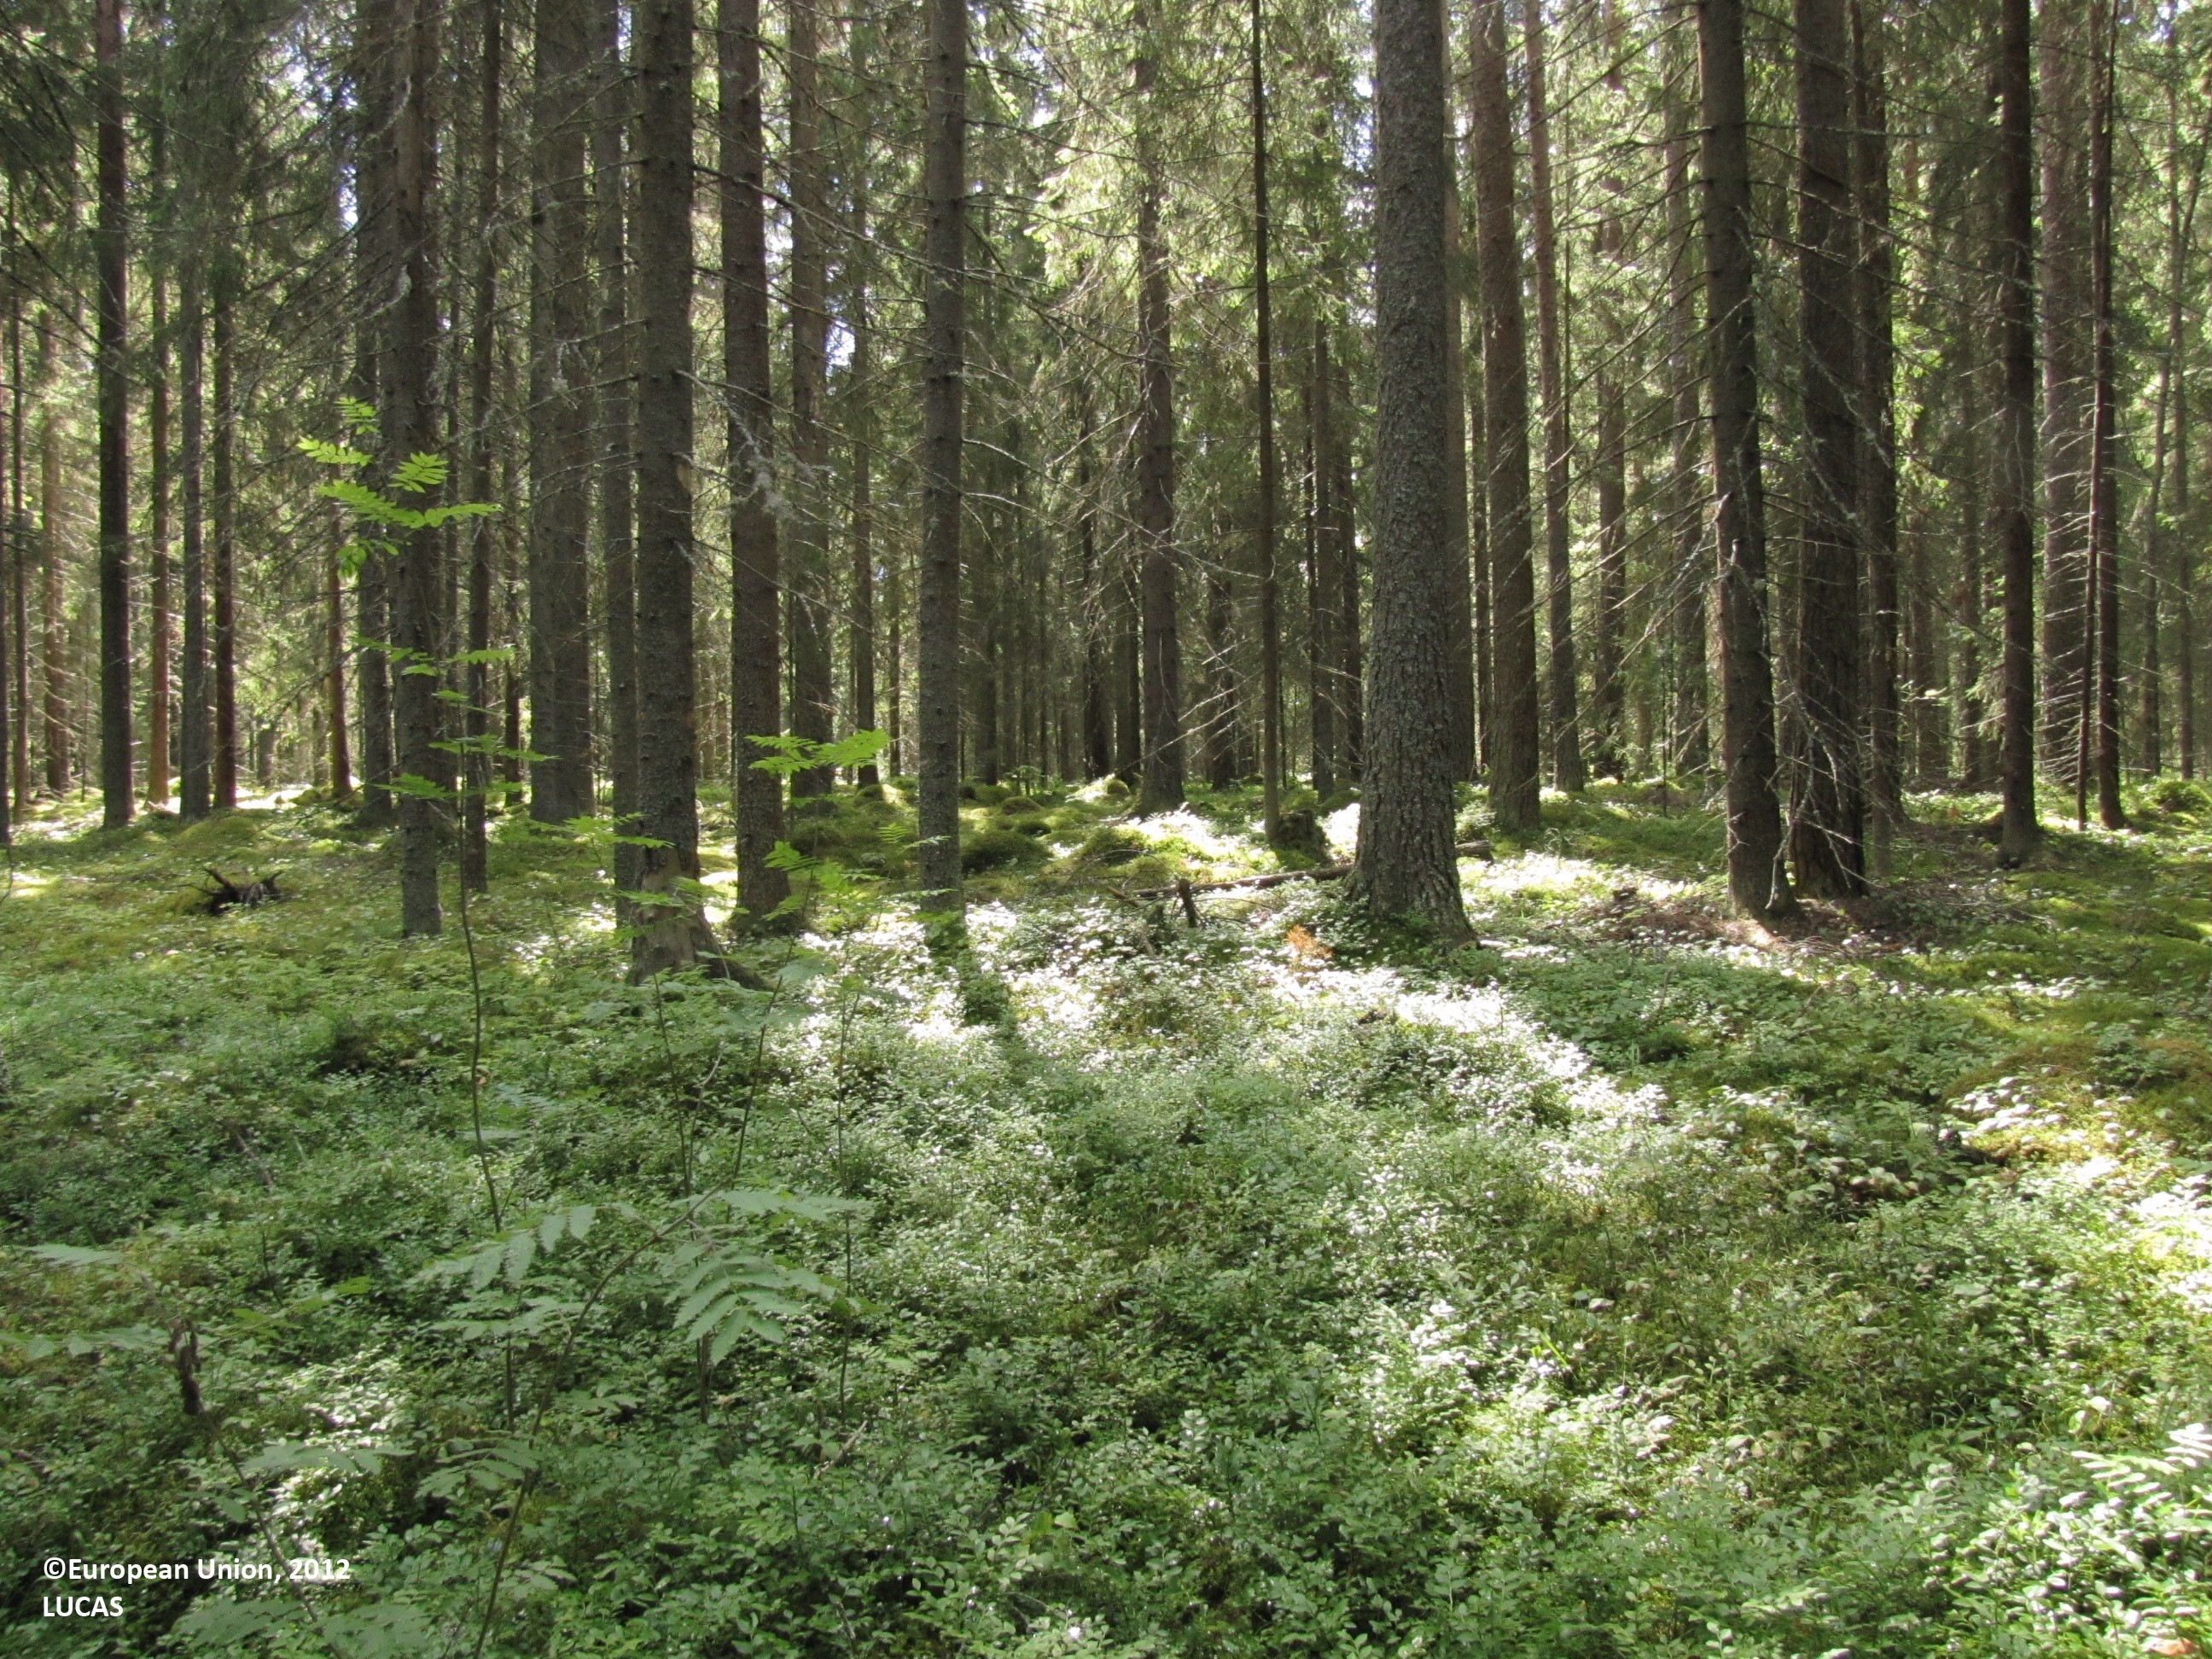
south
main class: Woodland
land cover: Spruce dominated coniferous woodland
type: boreal forest
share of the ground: > 75 %
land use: Forestry
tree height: > 5 m
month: July
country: FI
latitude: 62.4717
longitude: 23.1568
